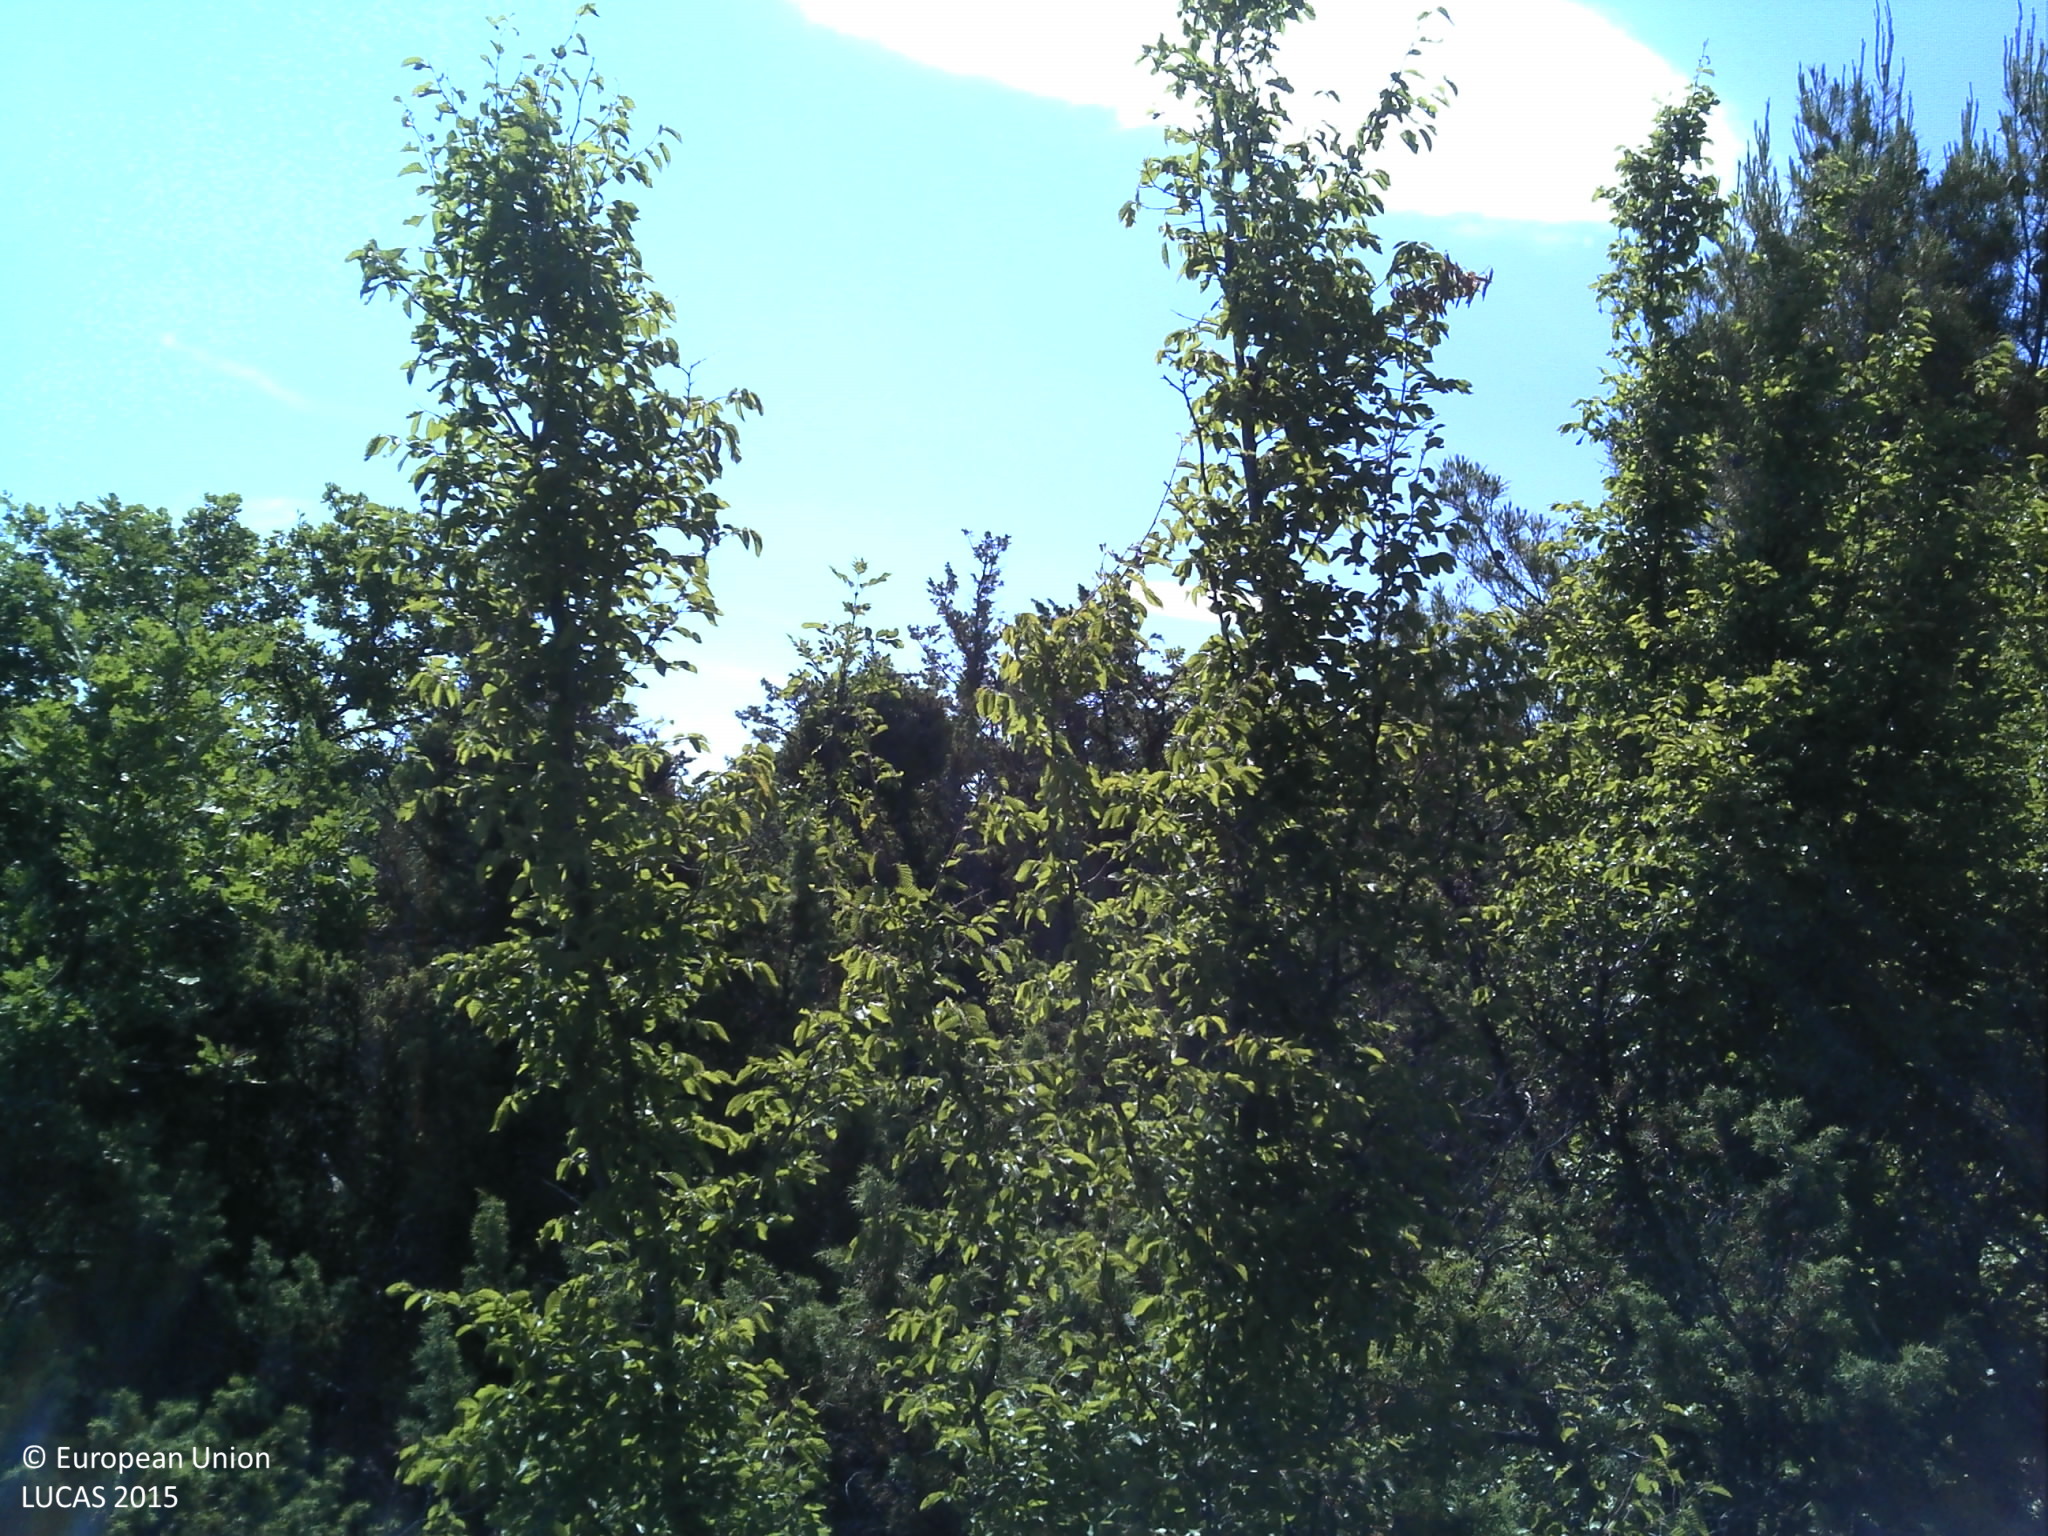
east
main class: Shrubland
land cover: Shrubland with sparse tree cover
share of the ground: > 75 %
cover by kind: shrubs 75 %, consolidated bare surface 20 %, broadleaved forest trees 5 %
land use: Semi-natural and natural areas not in use
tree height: > 5 m
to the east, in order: Shrubland with sparse tree cover
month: July
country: HR
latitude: 43.8291
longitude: 16.0724
